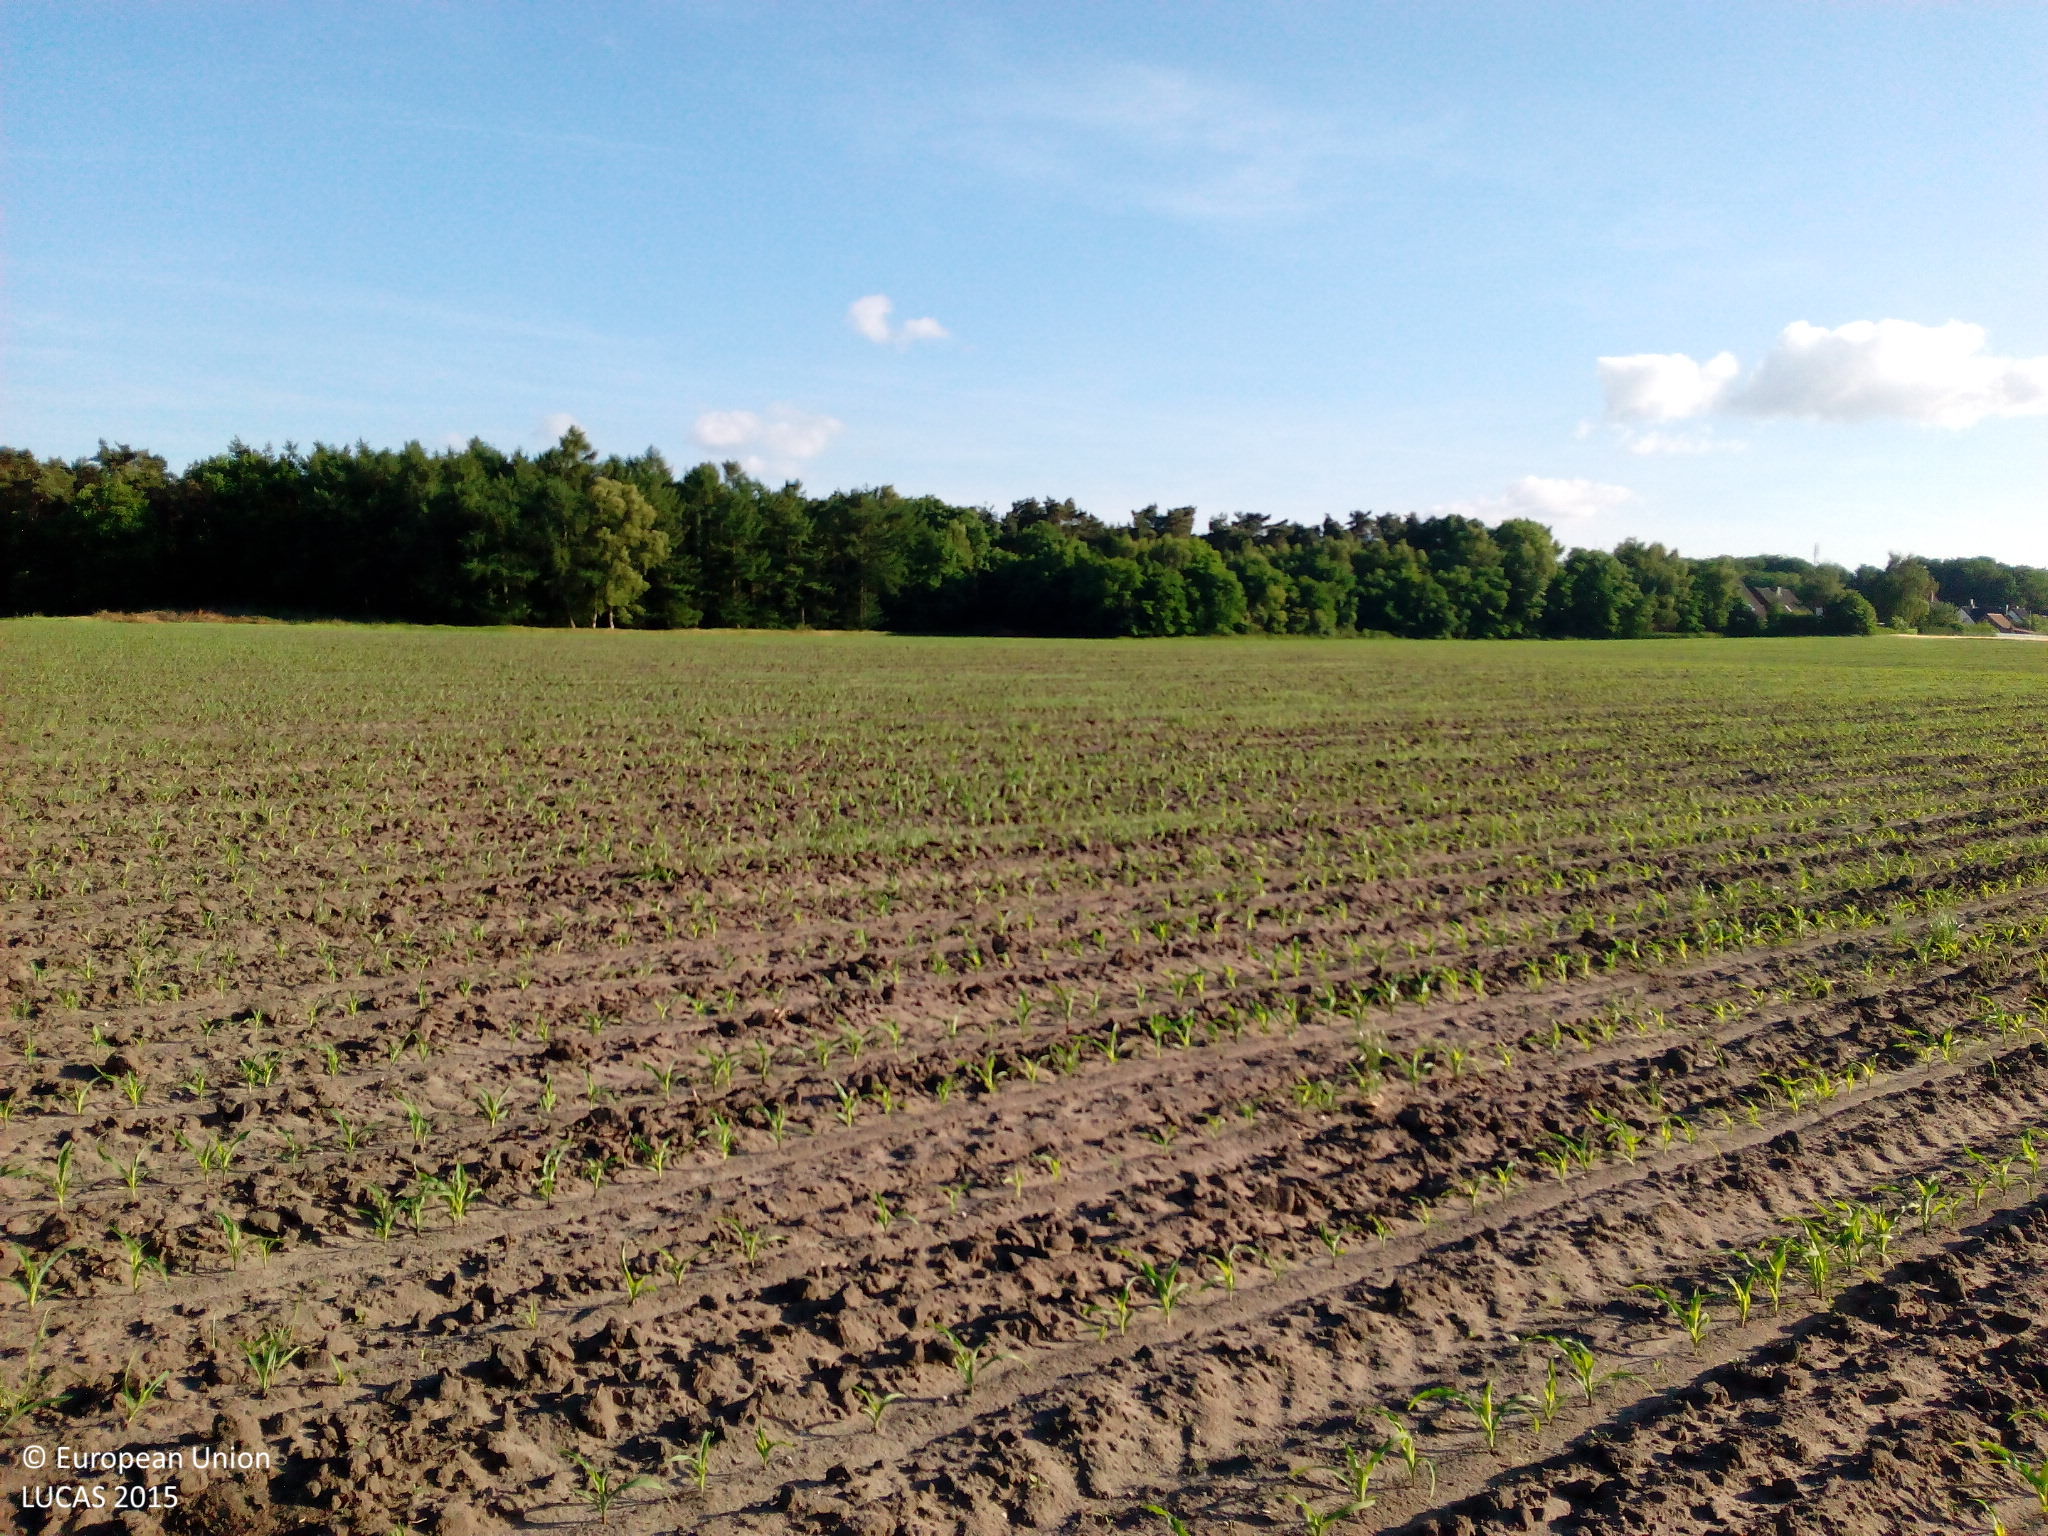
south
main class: Cropland
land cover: Maize
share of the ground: < 10 %
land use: Agriculture (excluding fallow land and kitchen gardens)
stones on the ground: < 10 %
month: June
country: DE
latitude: 52.5114
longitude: 7.4218
